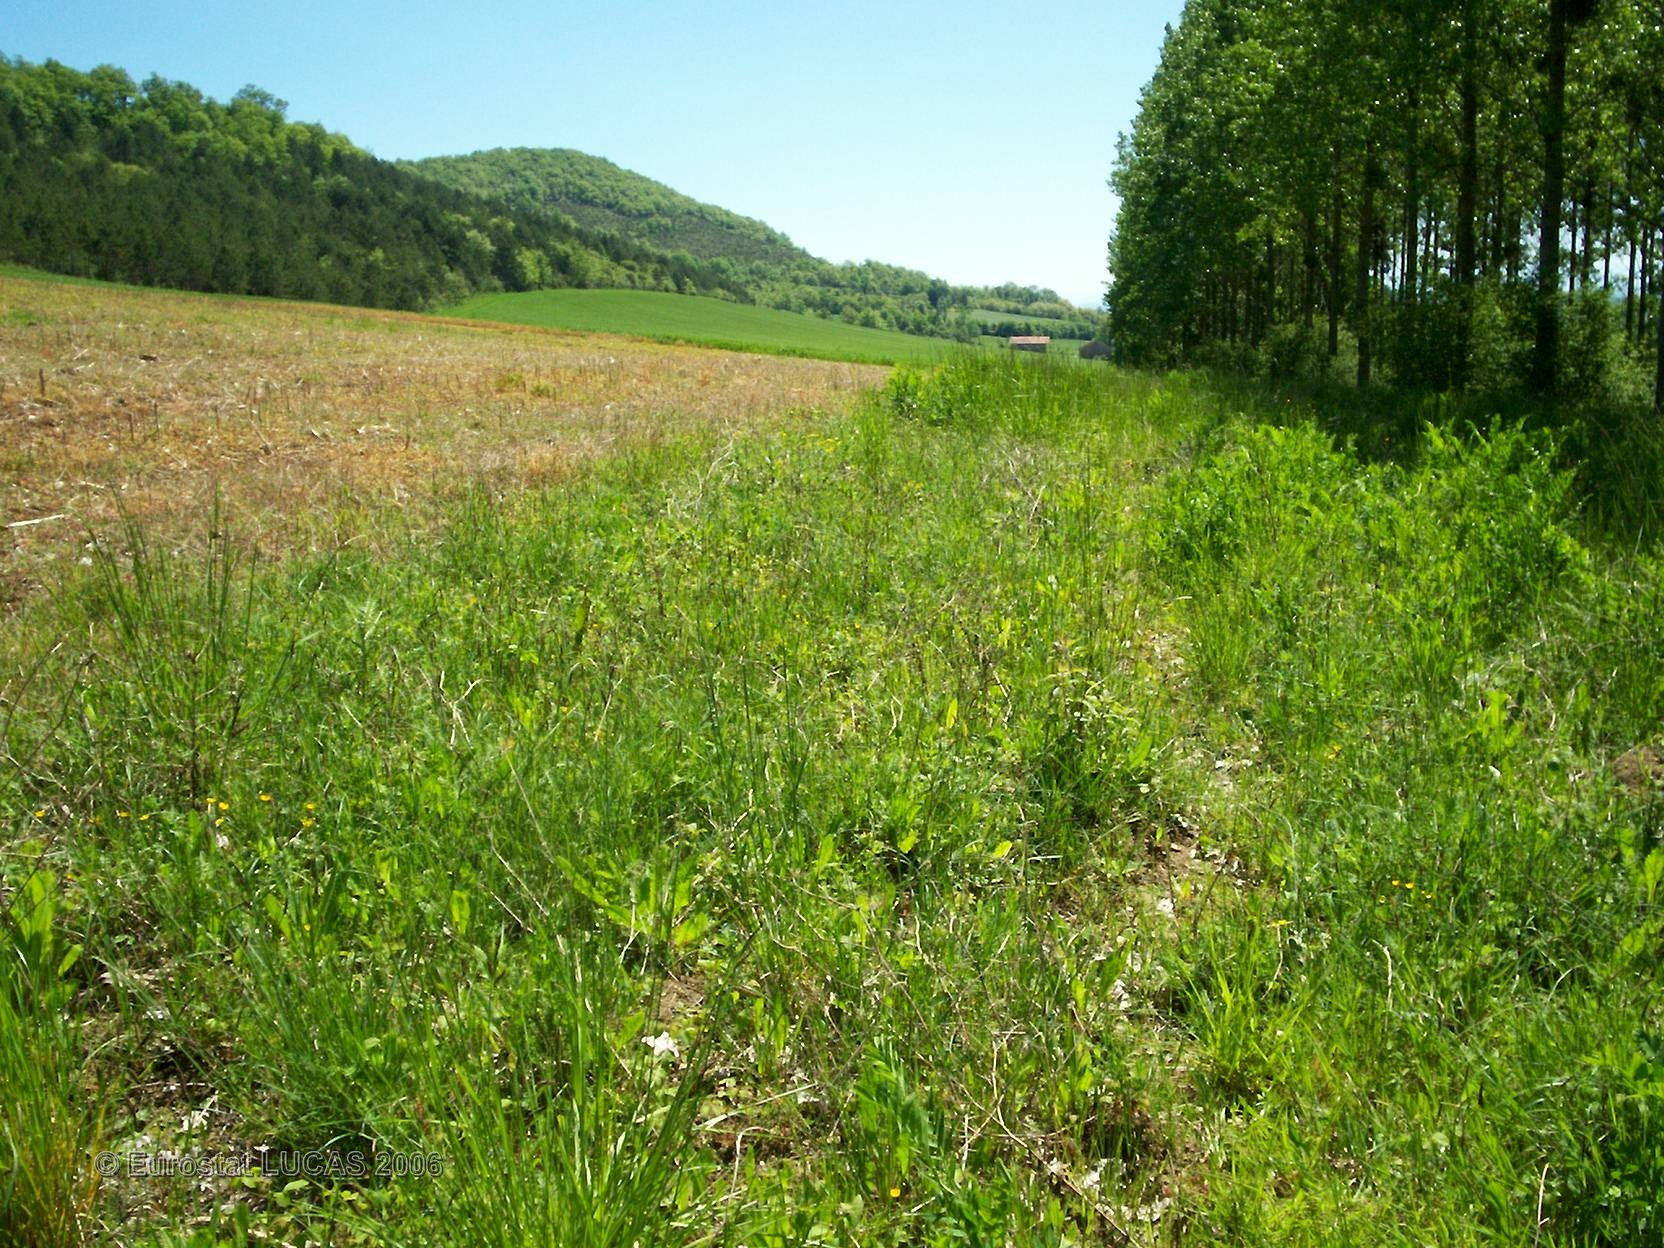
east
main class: Grassland
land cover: Grassland without tree/shrub cover
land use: Agriculture (excluding fallow land and kitchen gardens)
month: May
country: FR
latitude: 43.1529
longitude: 0.9149
